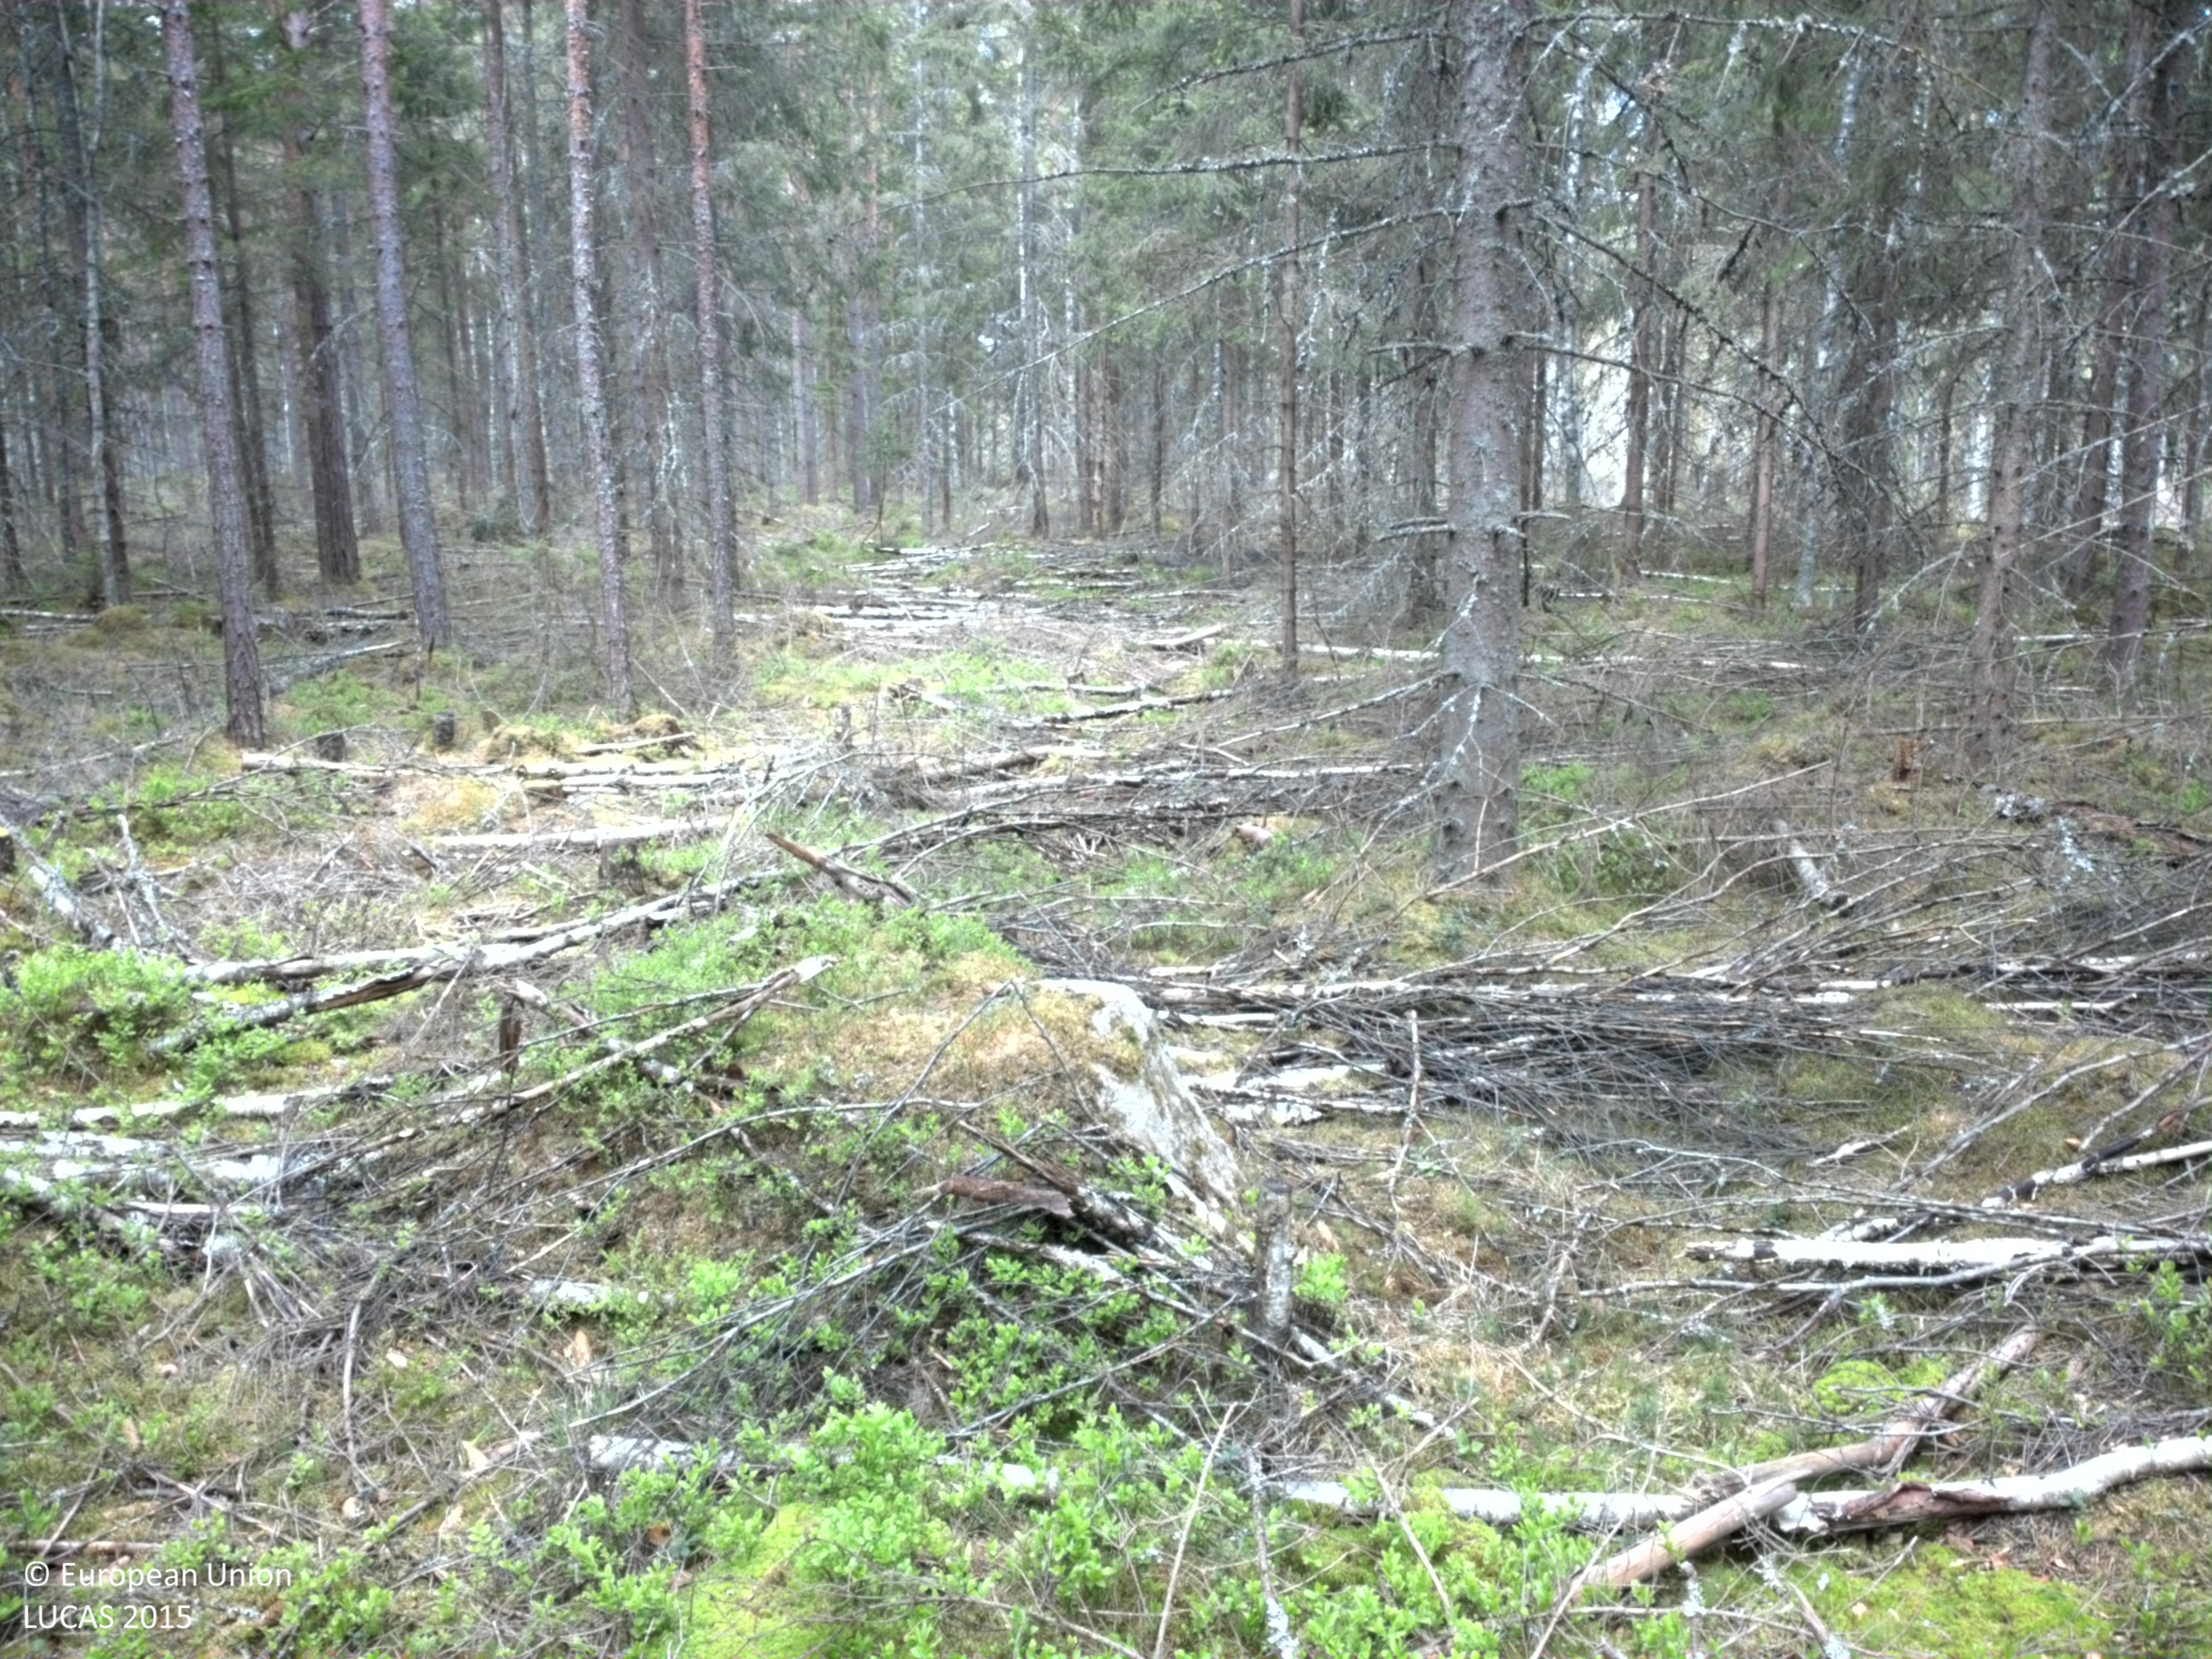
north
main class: Woodland
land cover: Spruce dominated coniferous woodland
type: boreal forest
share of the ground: > 75 %
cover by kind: coniferous forest trees 90 %, broadleaved forest trees 5 %, lichens and mosses 5 %
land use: Forestry
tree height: > 5 m
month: May
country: SE
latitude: 56.6496
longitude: 15.4297
